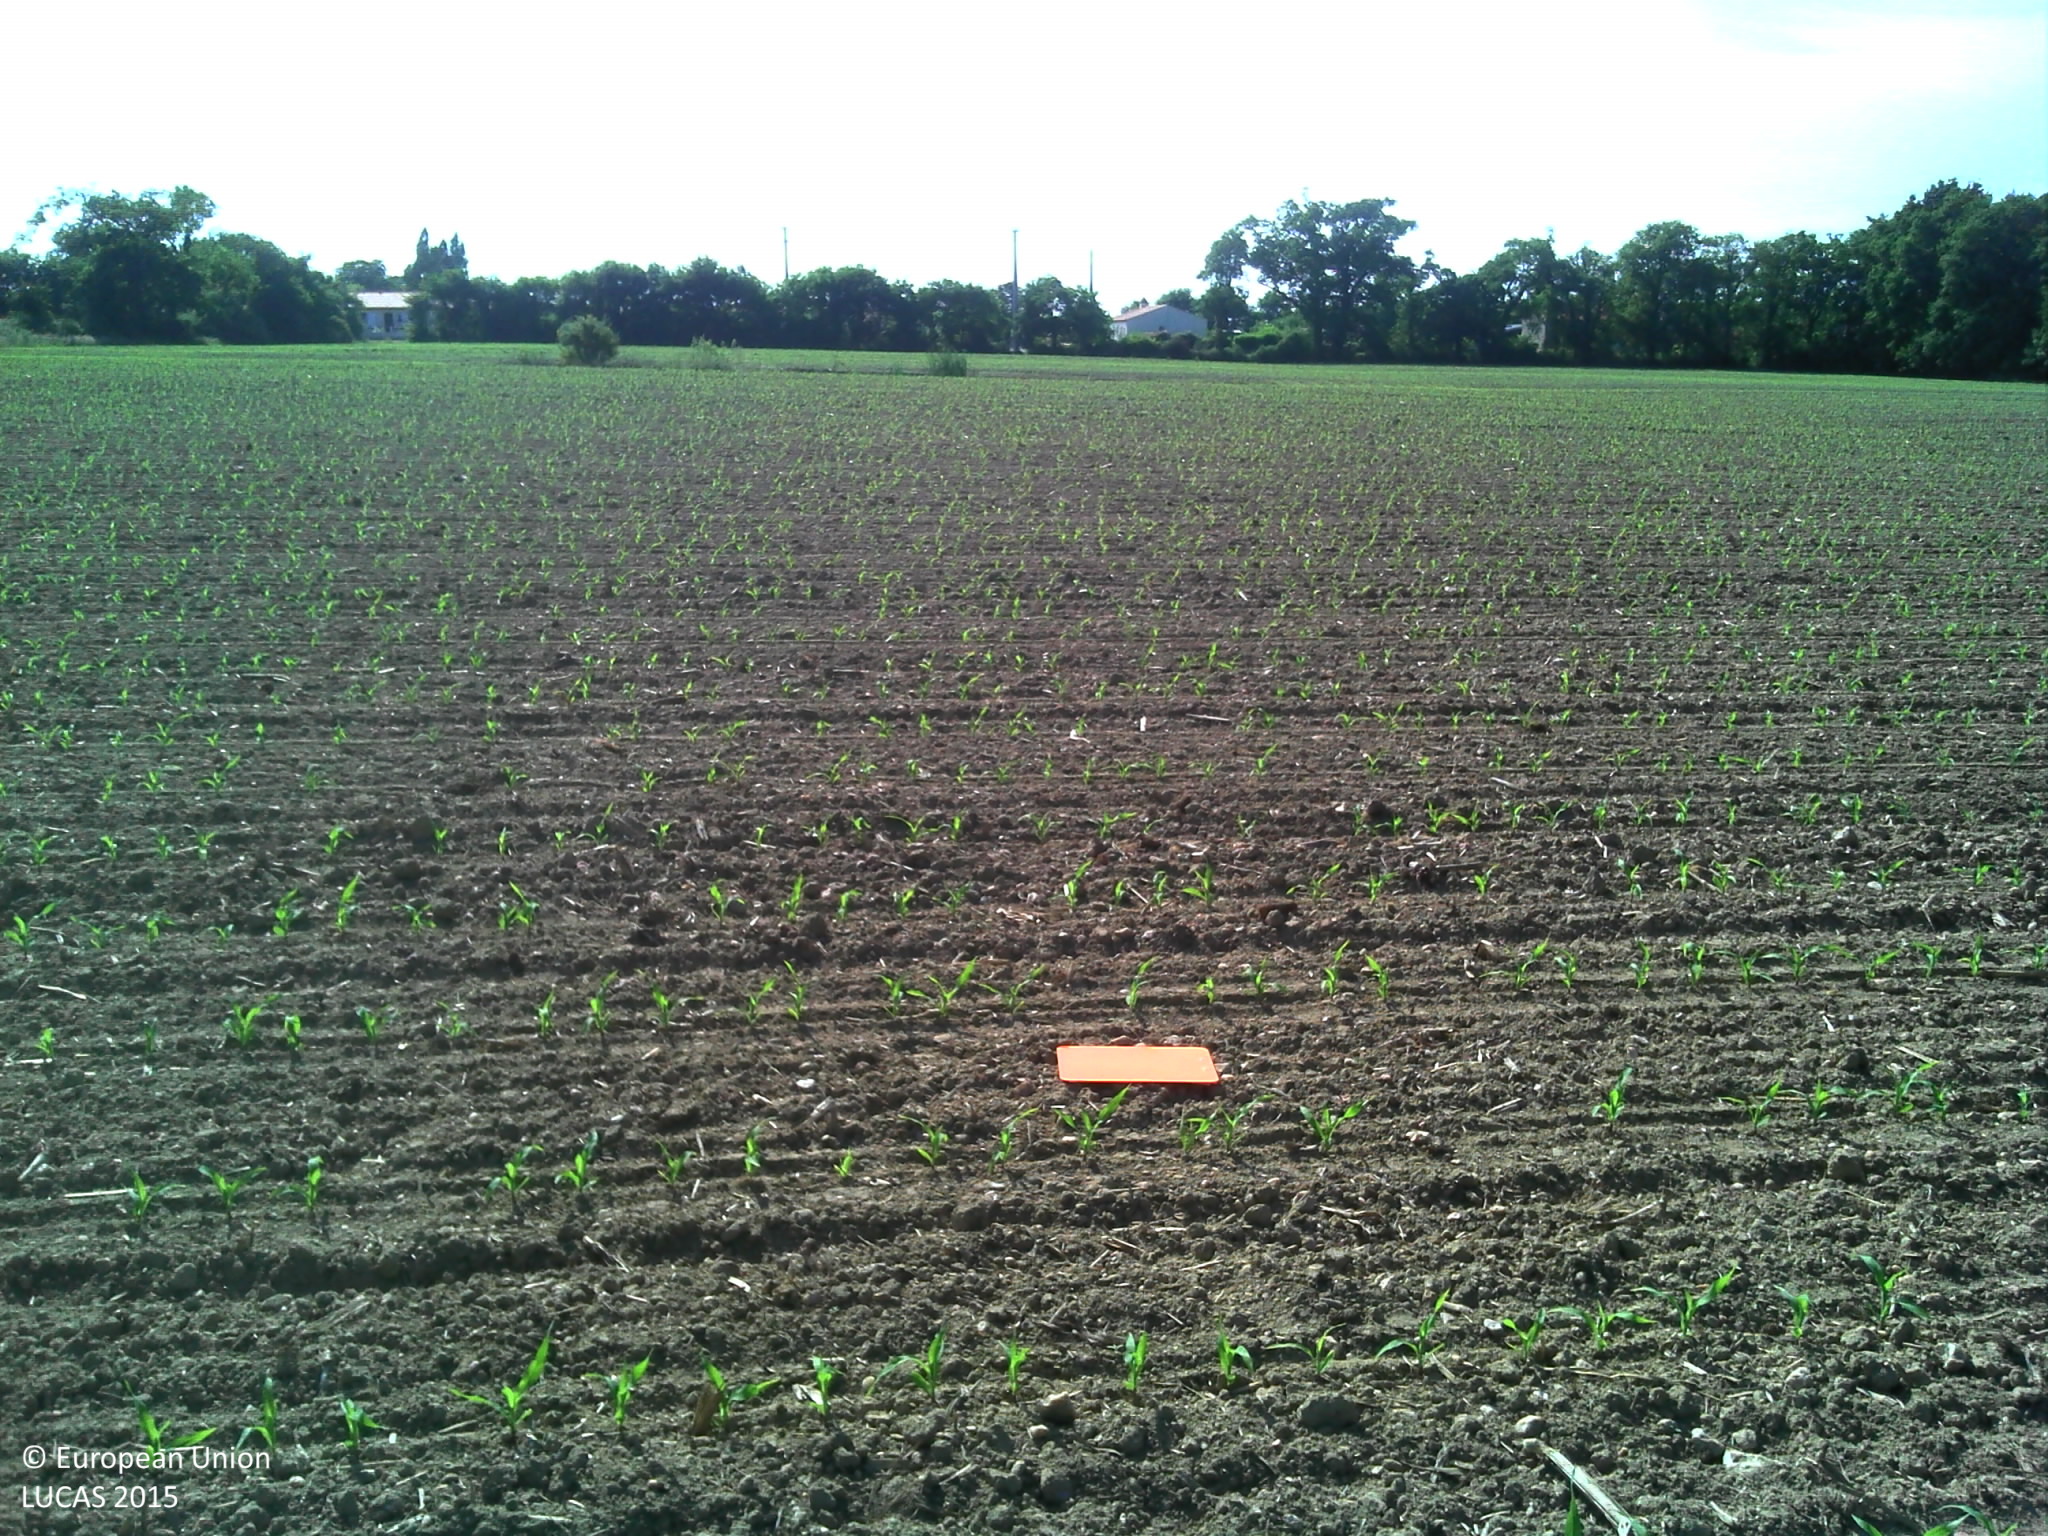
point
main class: Cropland
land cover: Maize
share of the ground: < 10 %
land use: Agriculture (excluding fallow land and kitchen gardens)
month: June
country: FR
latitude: 46.8645
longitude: -1.7574
